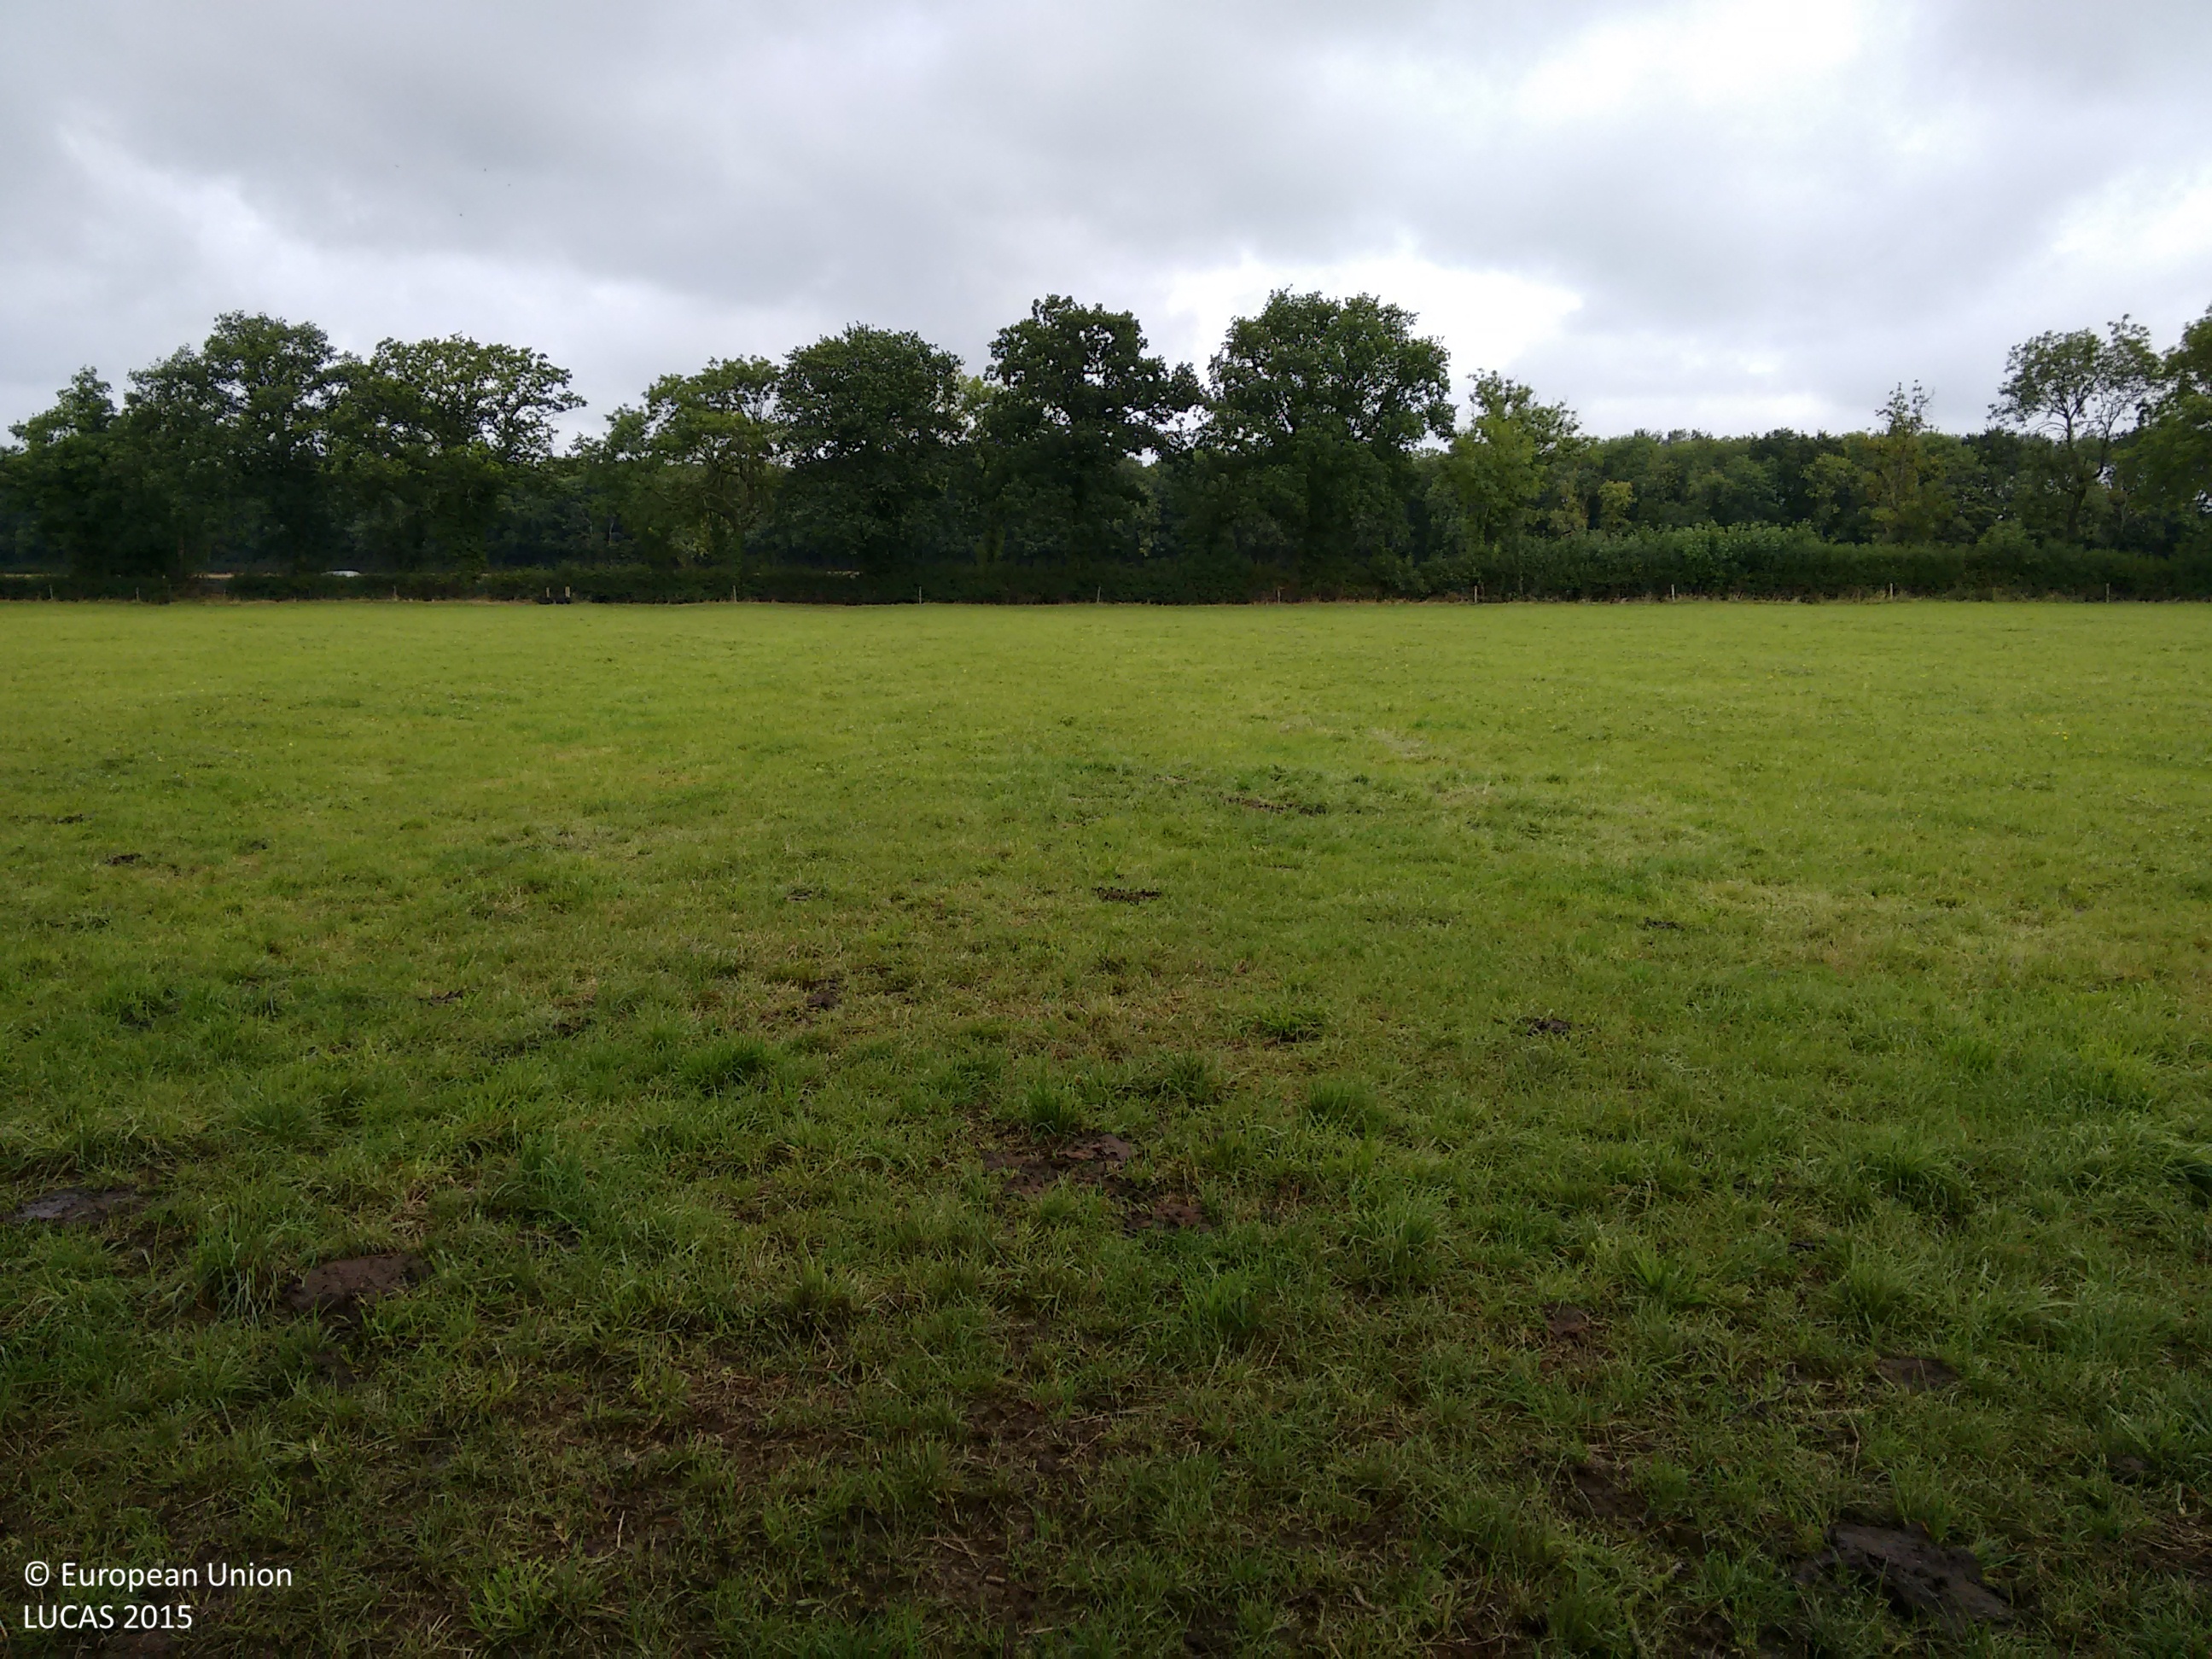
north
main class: Grassland
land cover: Grassland without tree/shrub cover
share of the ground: > 75 %
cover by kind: herbaceous plants 100 %
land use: Agriculture (excluding fallow land and kitchen gardens)
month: September
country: GB
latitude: 52.4285
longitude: -1.1797
